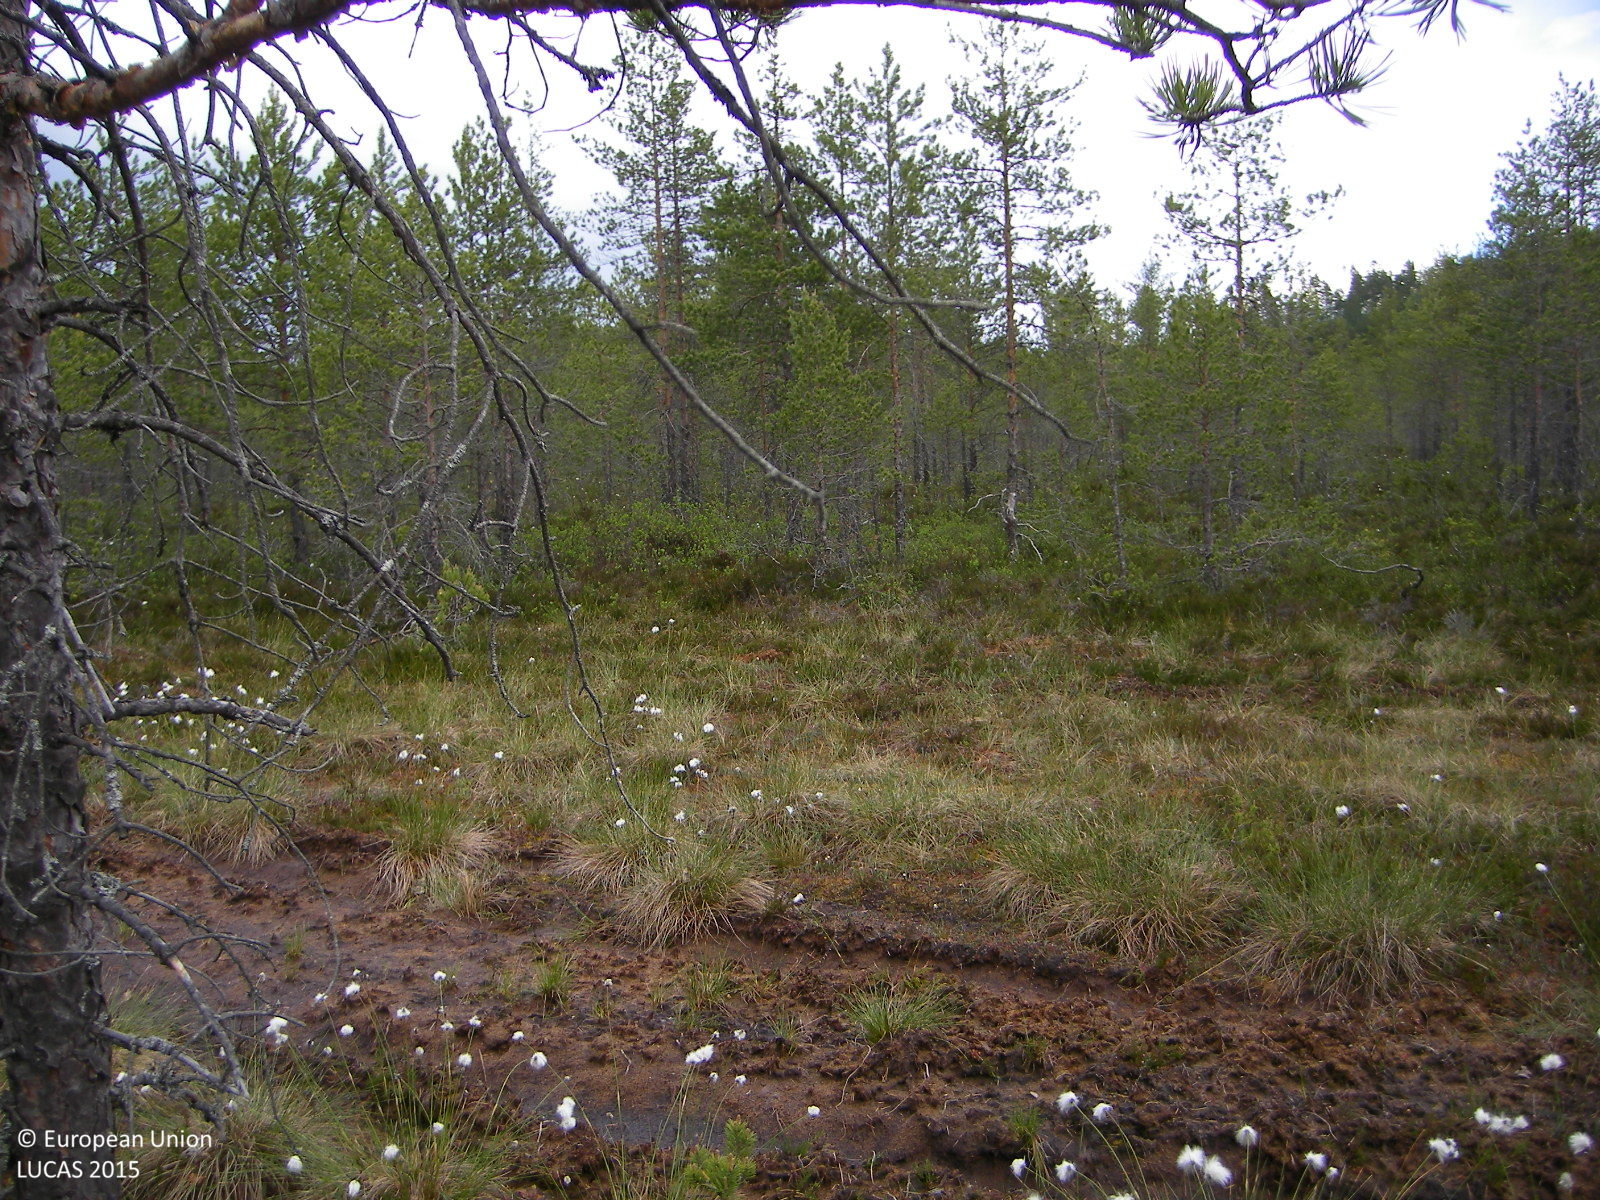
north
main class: Woodland
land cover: Pine dominated coniferous woodland
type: mire and swamp forests
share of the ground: 25 - 50 %
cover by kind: coniferous forest trees 45 %, shrubs 25 %, herbaceous plants 20 %, lichens and mosses 5 %, unconsolidated bare surface 5 %
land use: Semi-natural and natural areas not in use
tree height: < 5 m
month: June
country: FI
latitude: 60.3976
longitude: 24.6842
